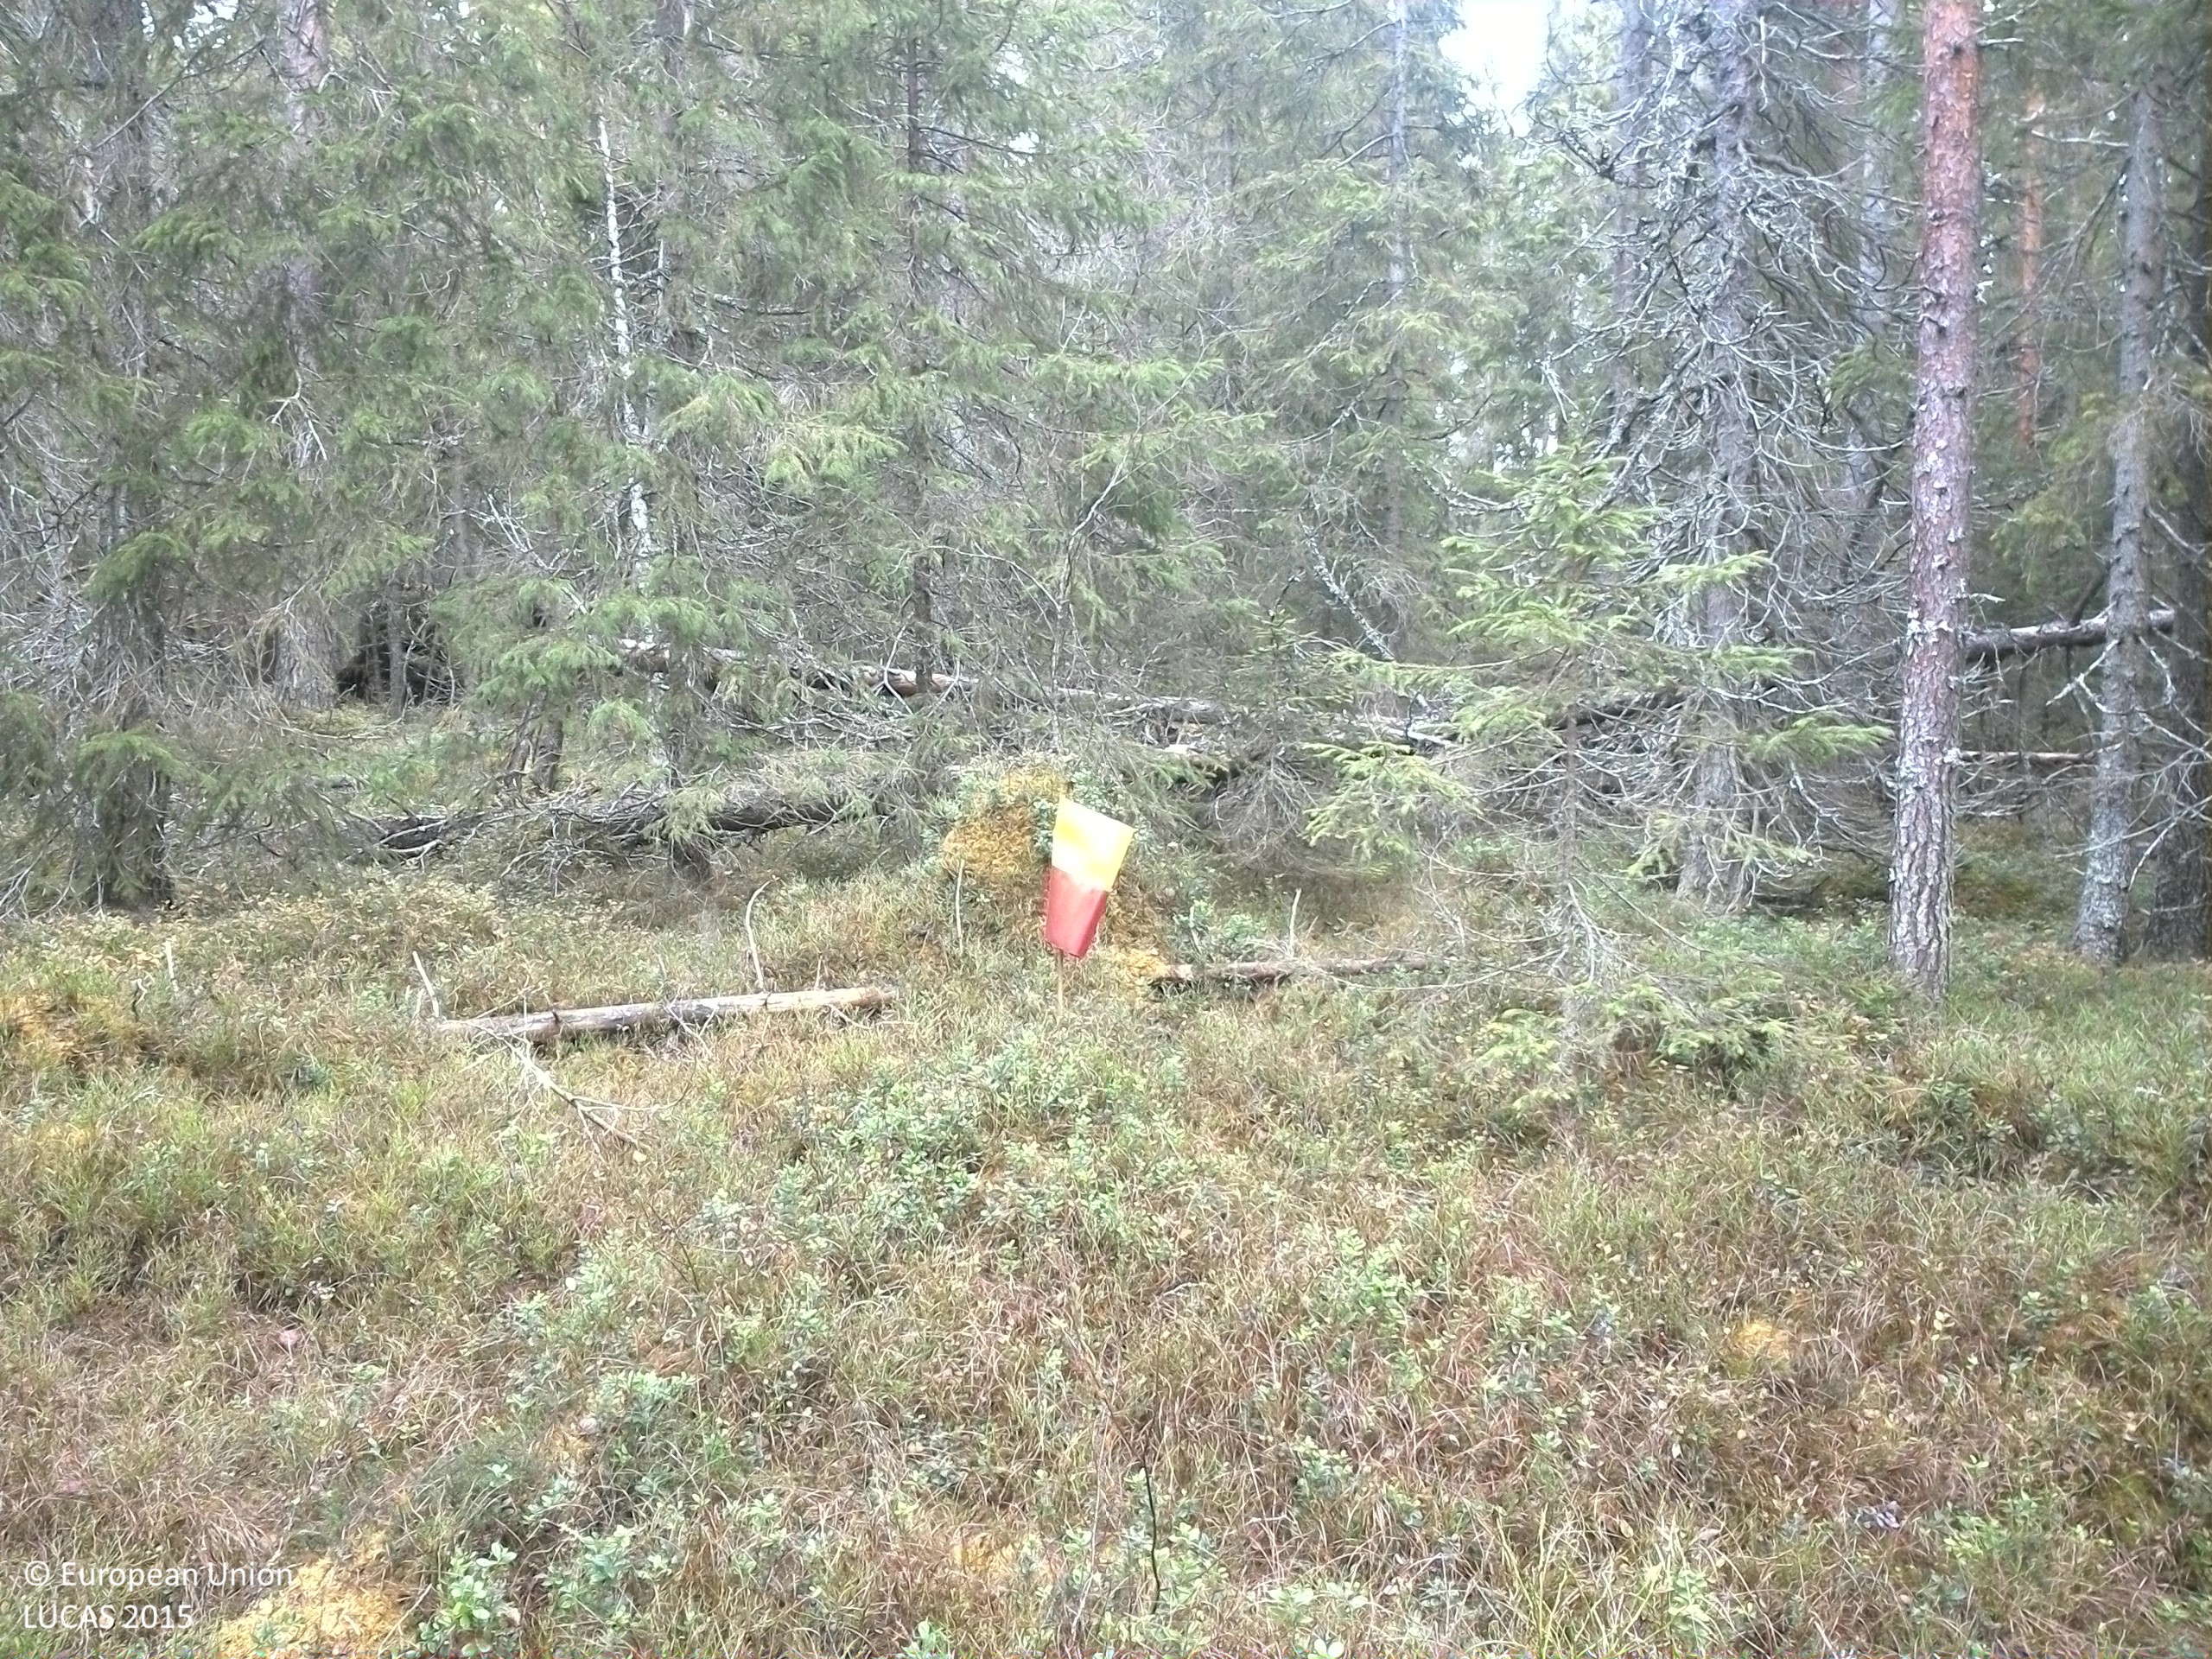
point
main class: Woodland
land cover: Spruce dominated coniferous woodland
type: boreal forest
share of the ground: 50 - 75 %
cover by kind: coniferous forest trees 50 %, shrubs 30 %, lichens and mosses 15 %, broadleaved forest trees 5 %
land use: Forestry
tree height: > 5 m
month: October
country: SE
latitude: 64.2449
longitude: 15.6022
